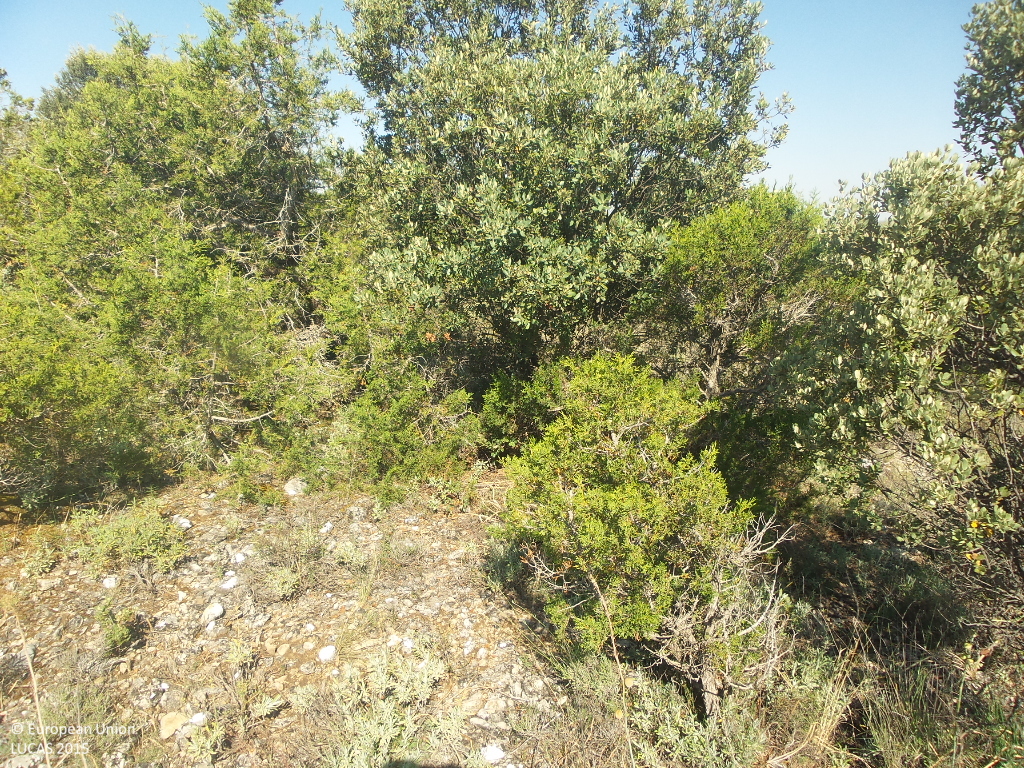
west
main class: Woodland
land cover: Other mixed woodland
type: coniferous forest of the mediterranean region
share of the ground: 50 - 75 %
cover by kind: coniferous forest trees 25 %, broadleaved forest trees 25 %, shrubs 25 %, unconsolidated bare surface 20 %, herbaceous plants 5 %
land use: Semi-natural and natural areas not in use
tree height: < 5 m
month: June
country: ES
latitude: 41.4494
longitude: -2.9804
